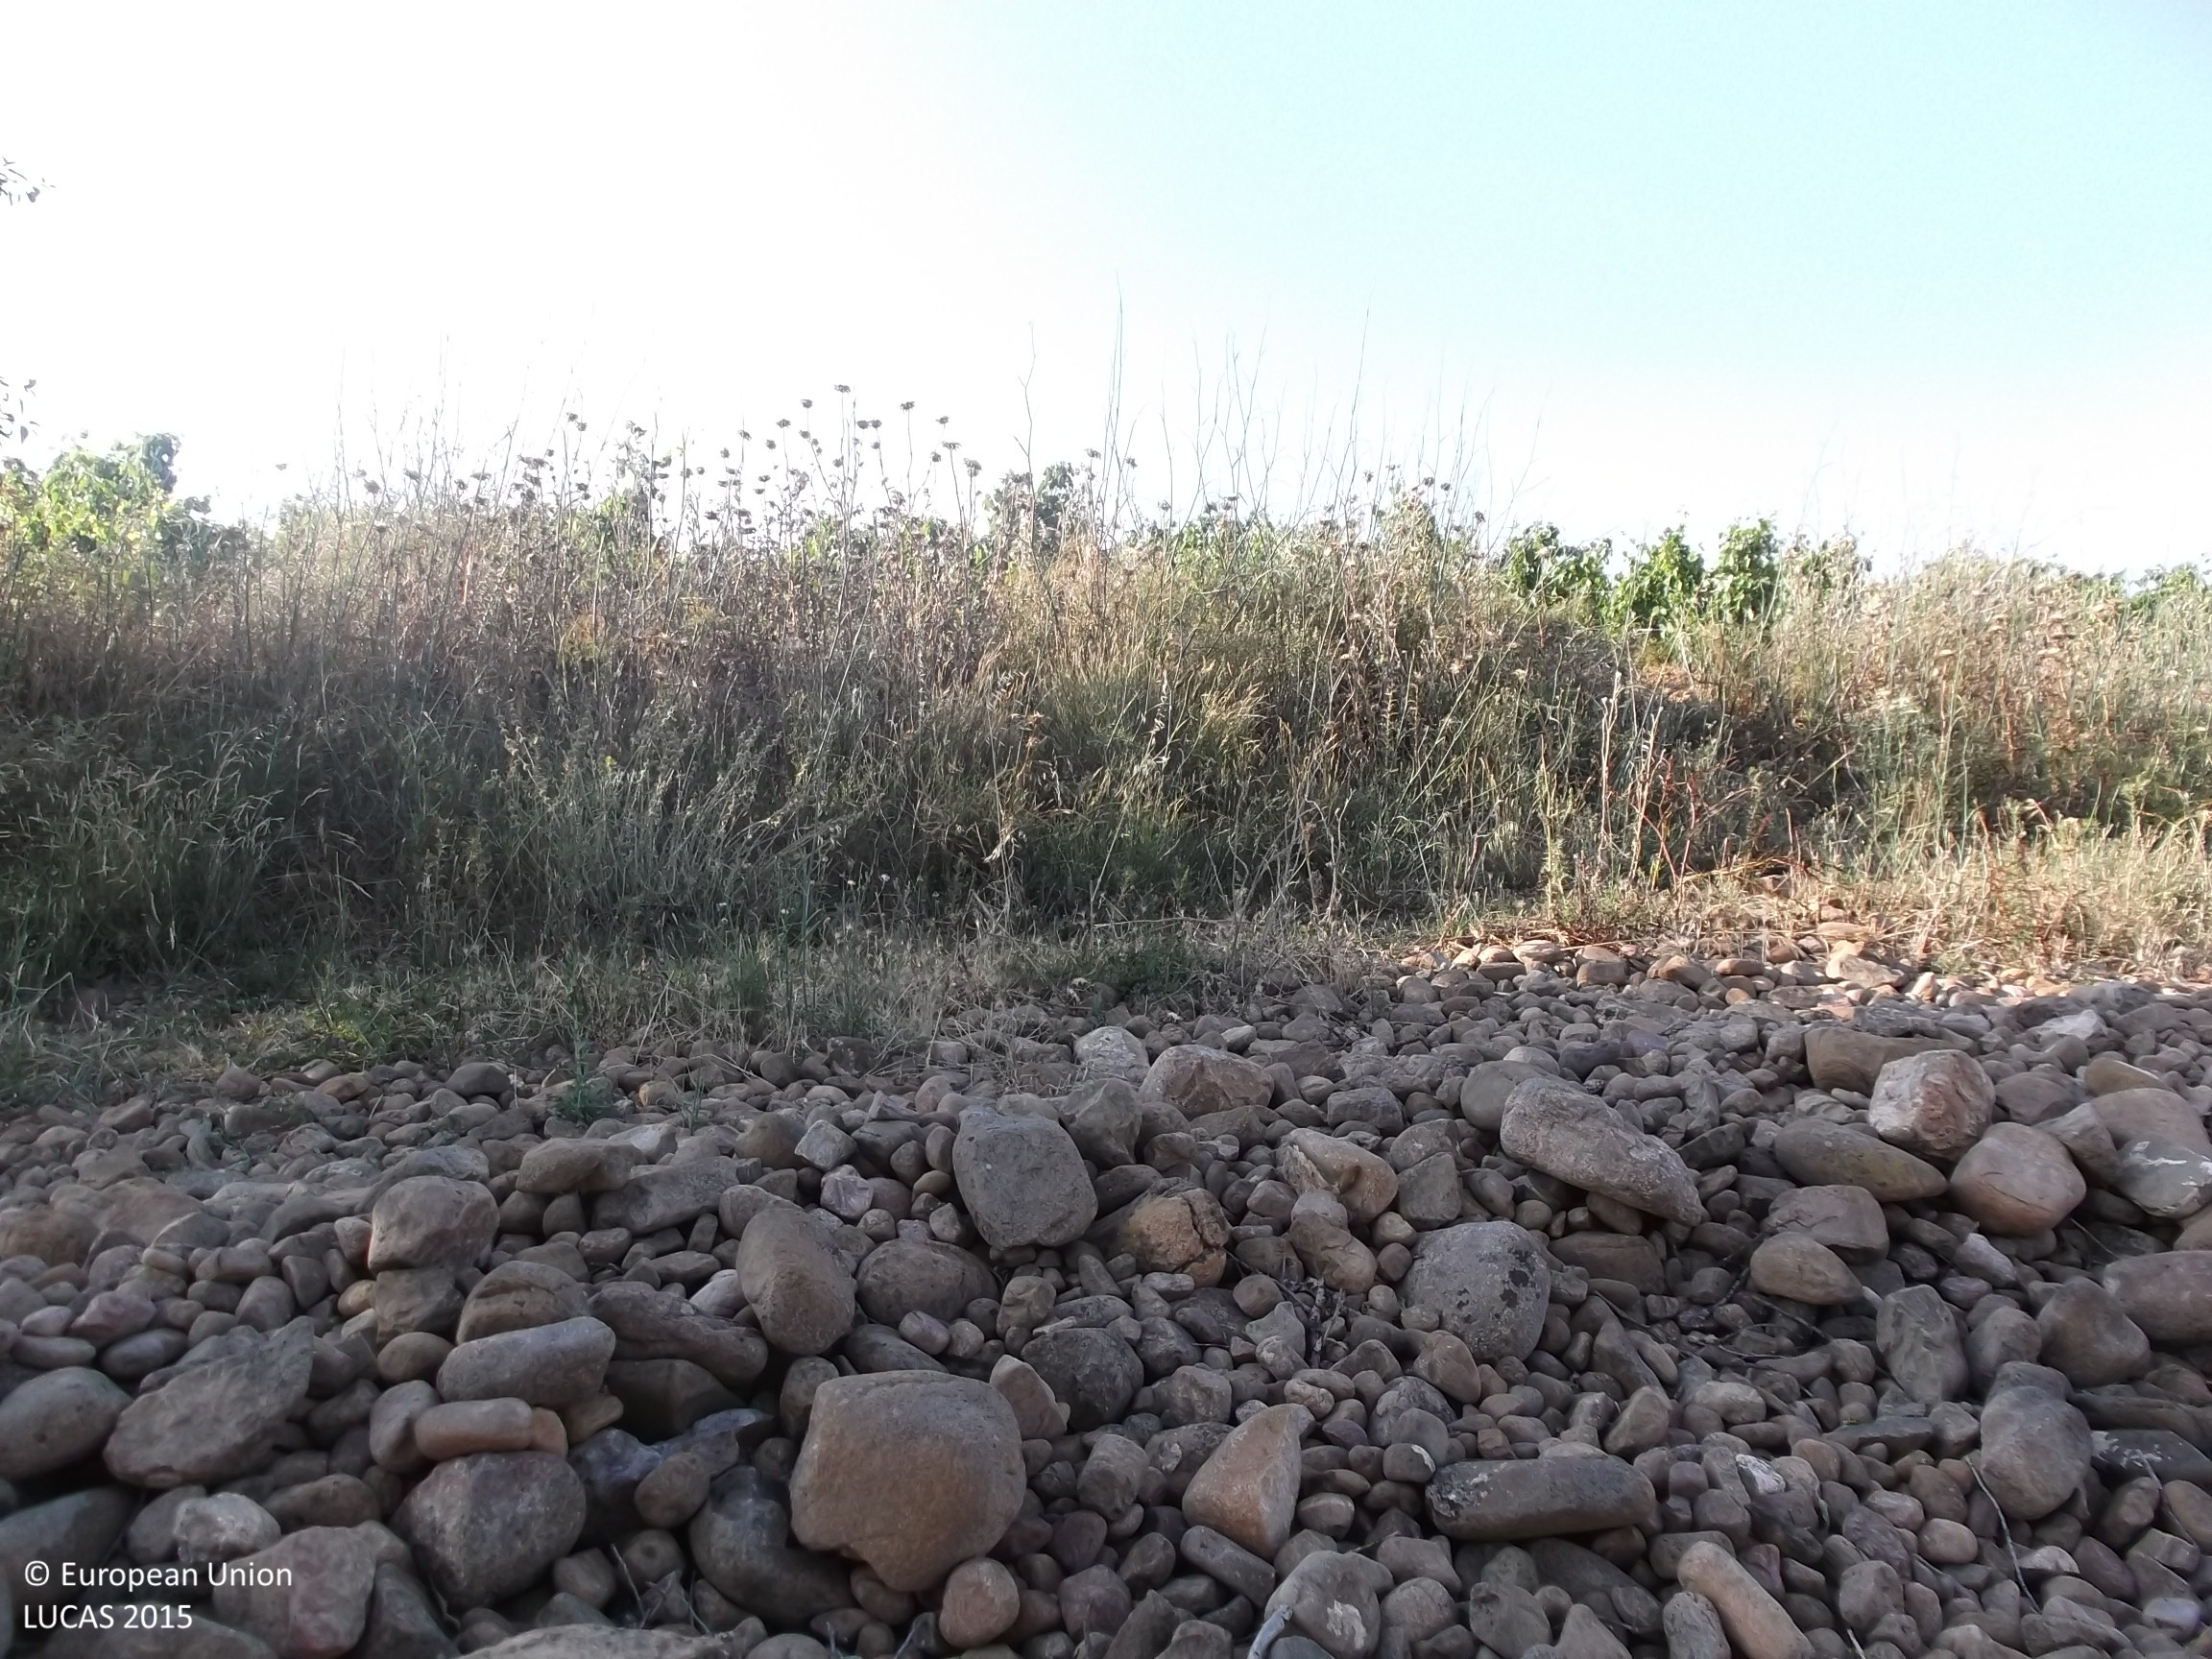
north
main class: Grassland
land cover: Grassland with sparse tree/shrub cover
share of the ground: 50 - 75 %
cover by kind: herbaceous plants 70 %, unconsolidated bare surface 25 %, broadleaved forest trees 5 %
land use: Semi-natural and natural areas not in use
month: June
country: ES
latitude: 42.3581
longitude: -2.1450
